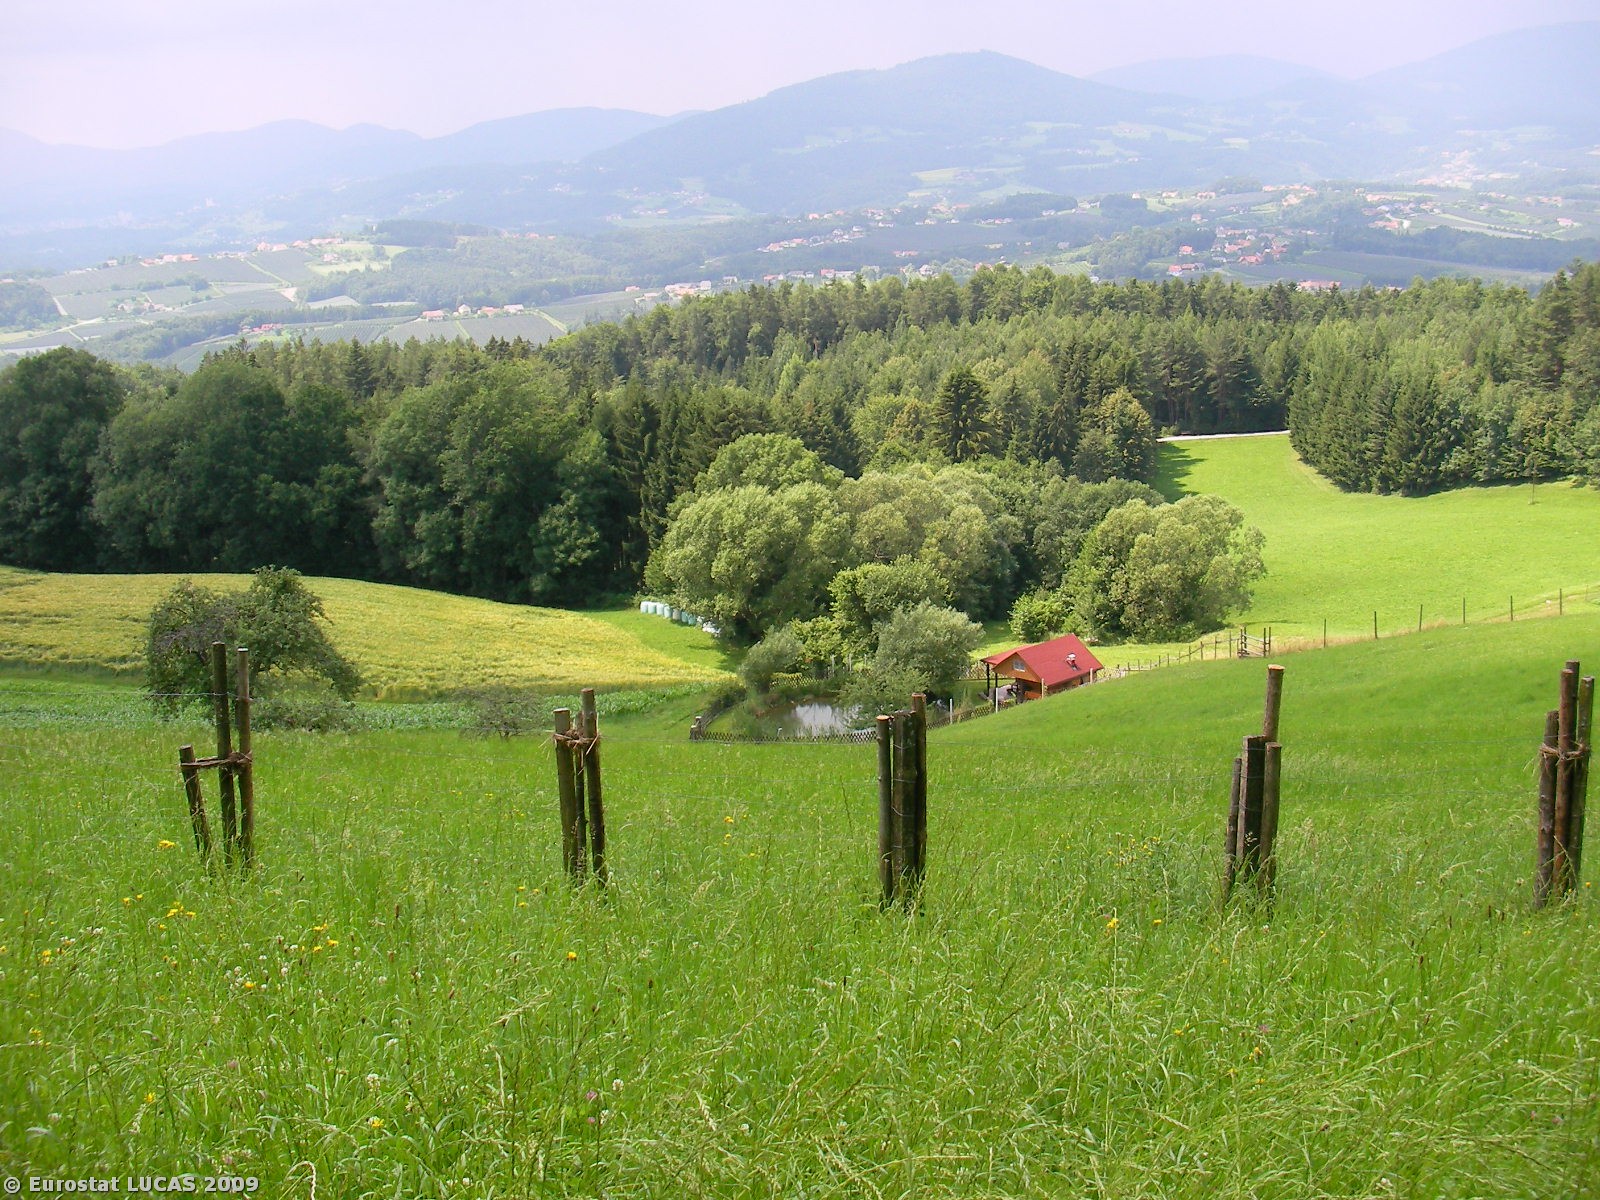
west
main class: Grassland
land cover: Grassland without tree/shrub cover
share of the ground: > 75 %
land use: Agriculture (excluding fallow land and kitchen gardens)
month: July
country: AT
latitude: 47.2257
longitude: 15.7458
